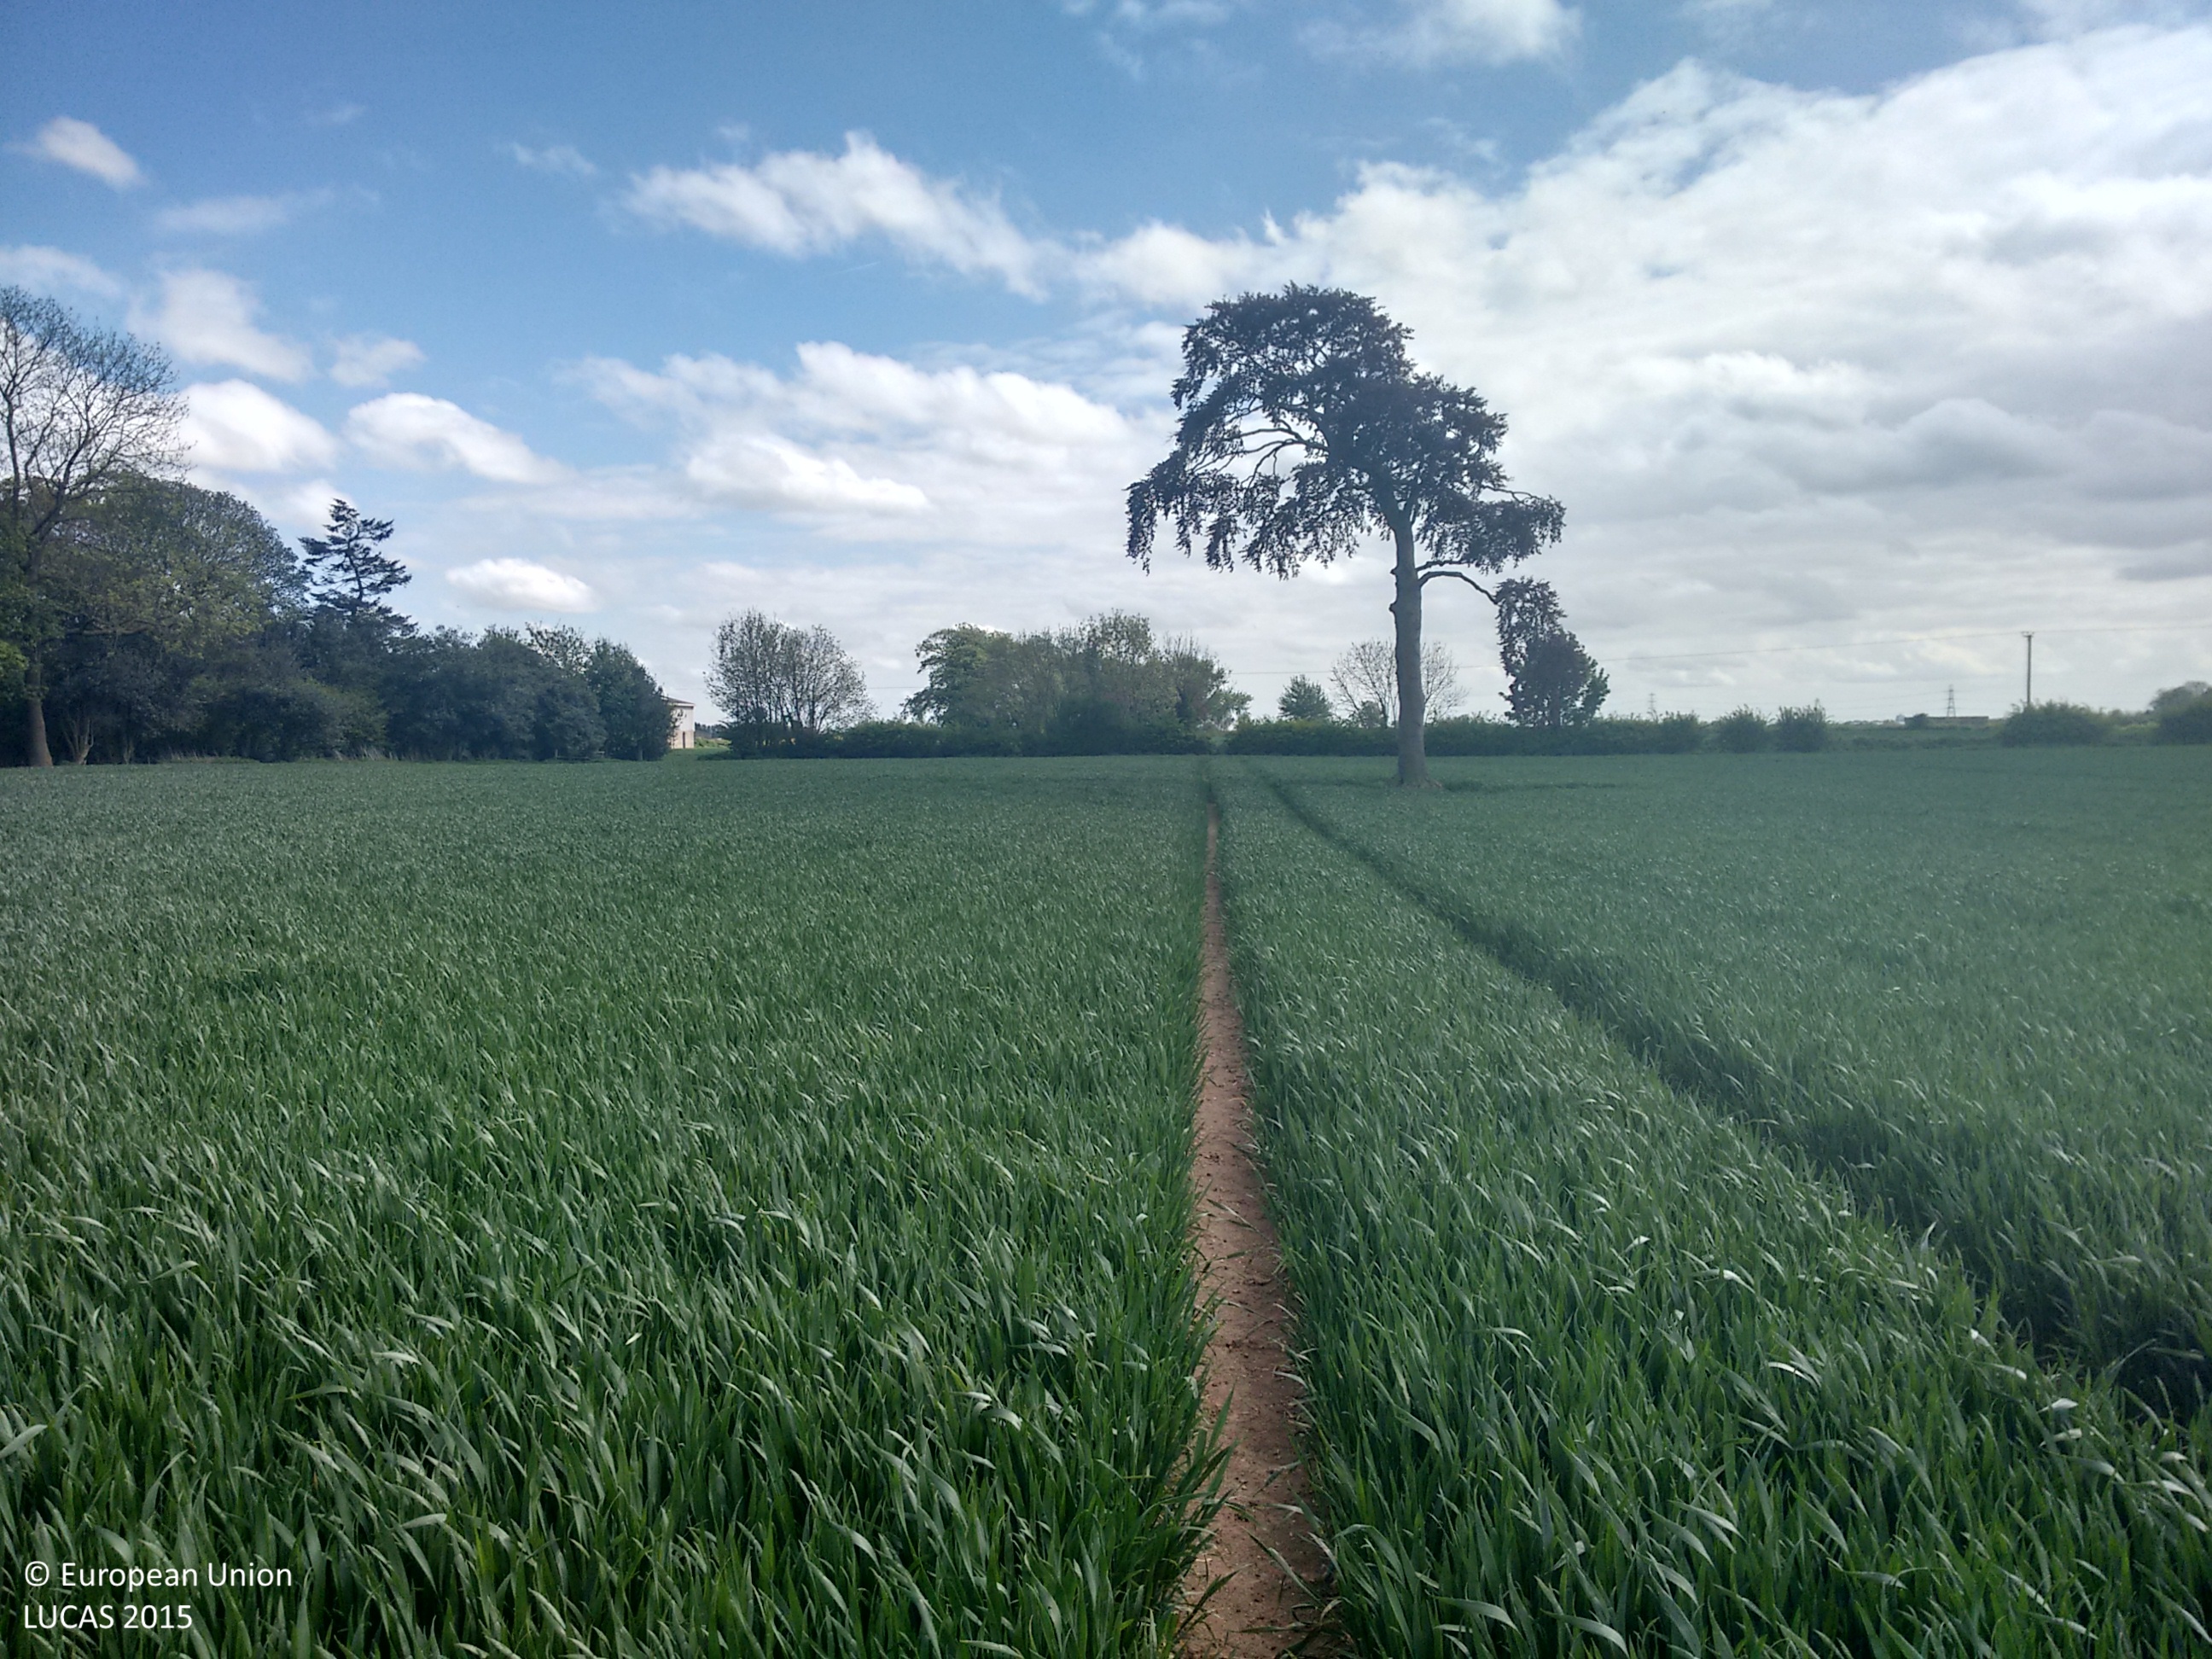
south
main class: Cropland
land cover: Common wheat
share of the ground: > 75 %
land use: Agriculture (excluding fallow land and kitchen gardens)
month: May
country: GB
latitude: 53.8326
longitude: -0.2908
